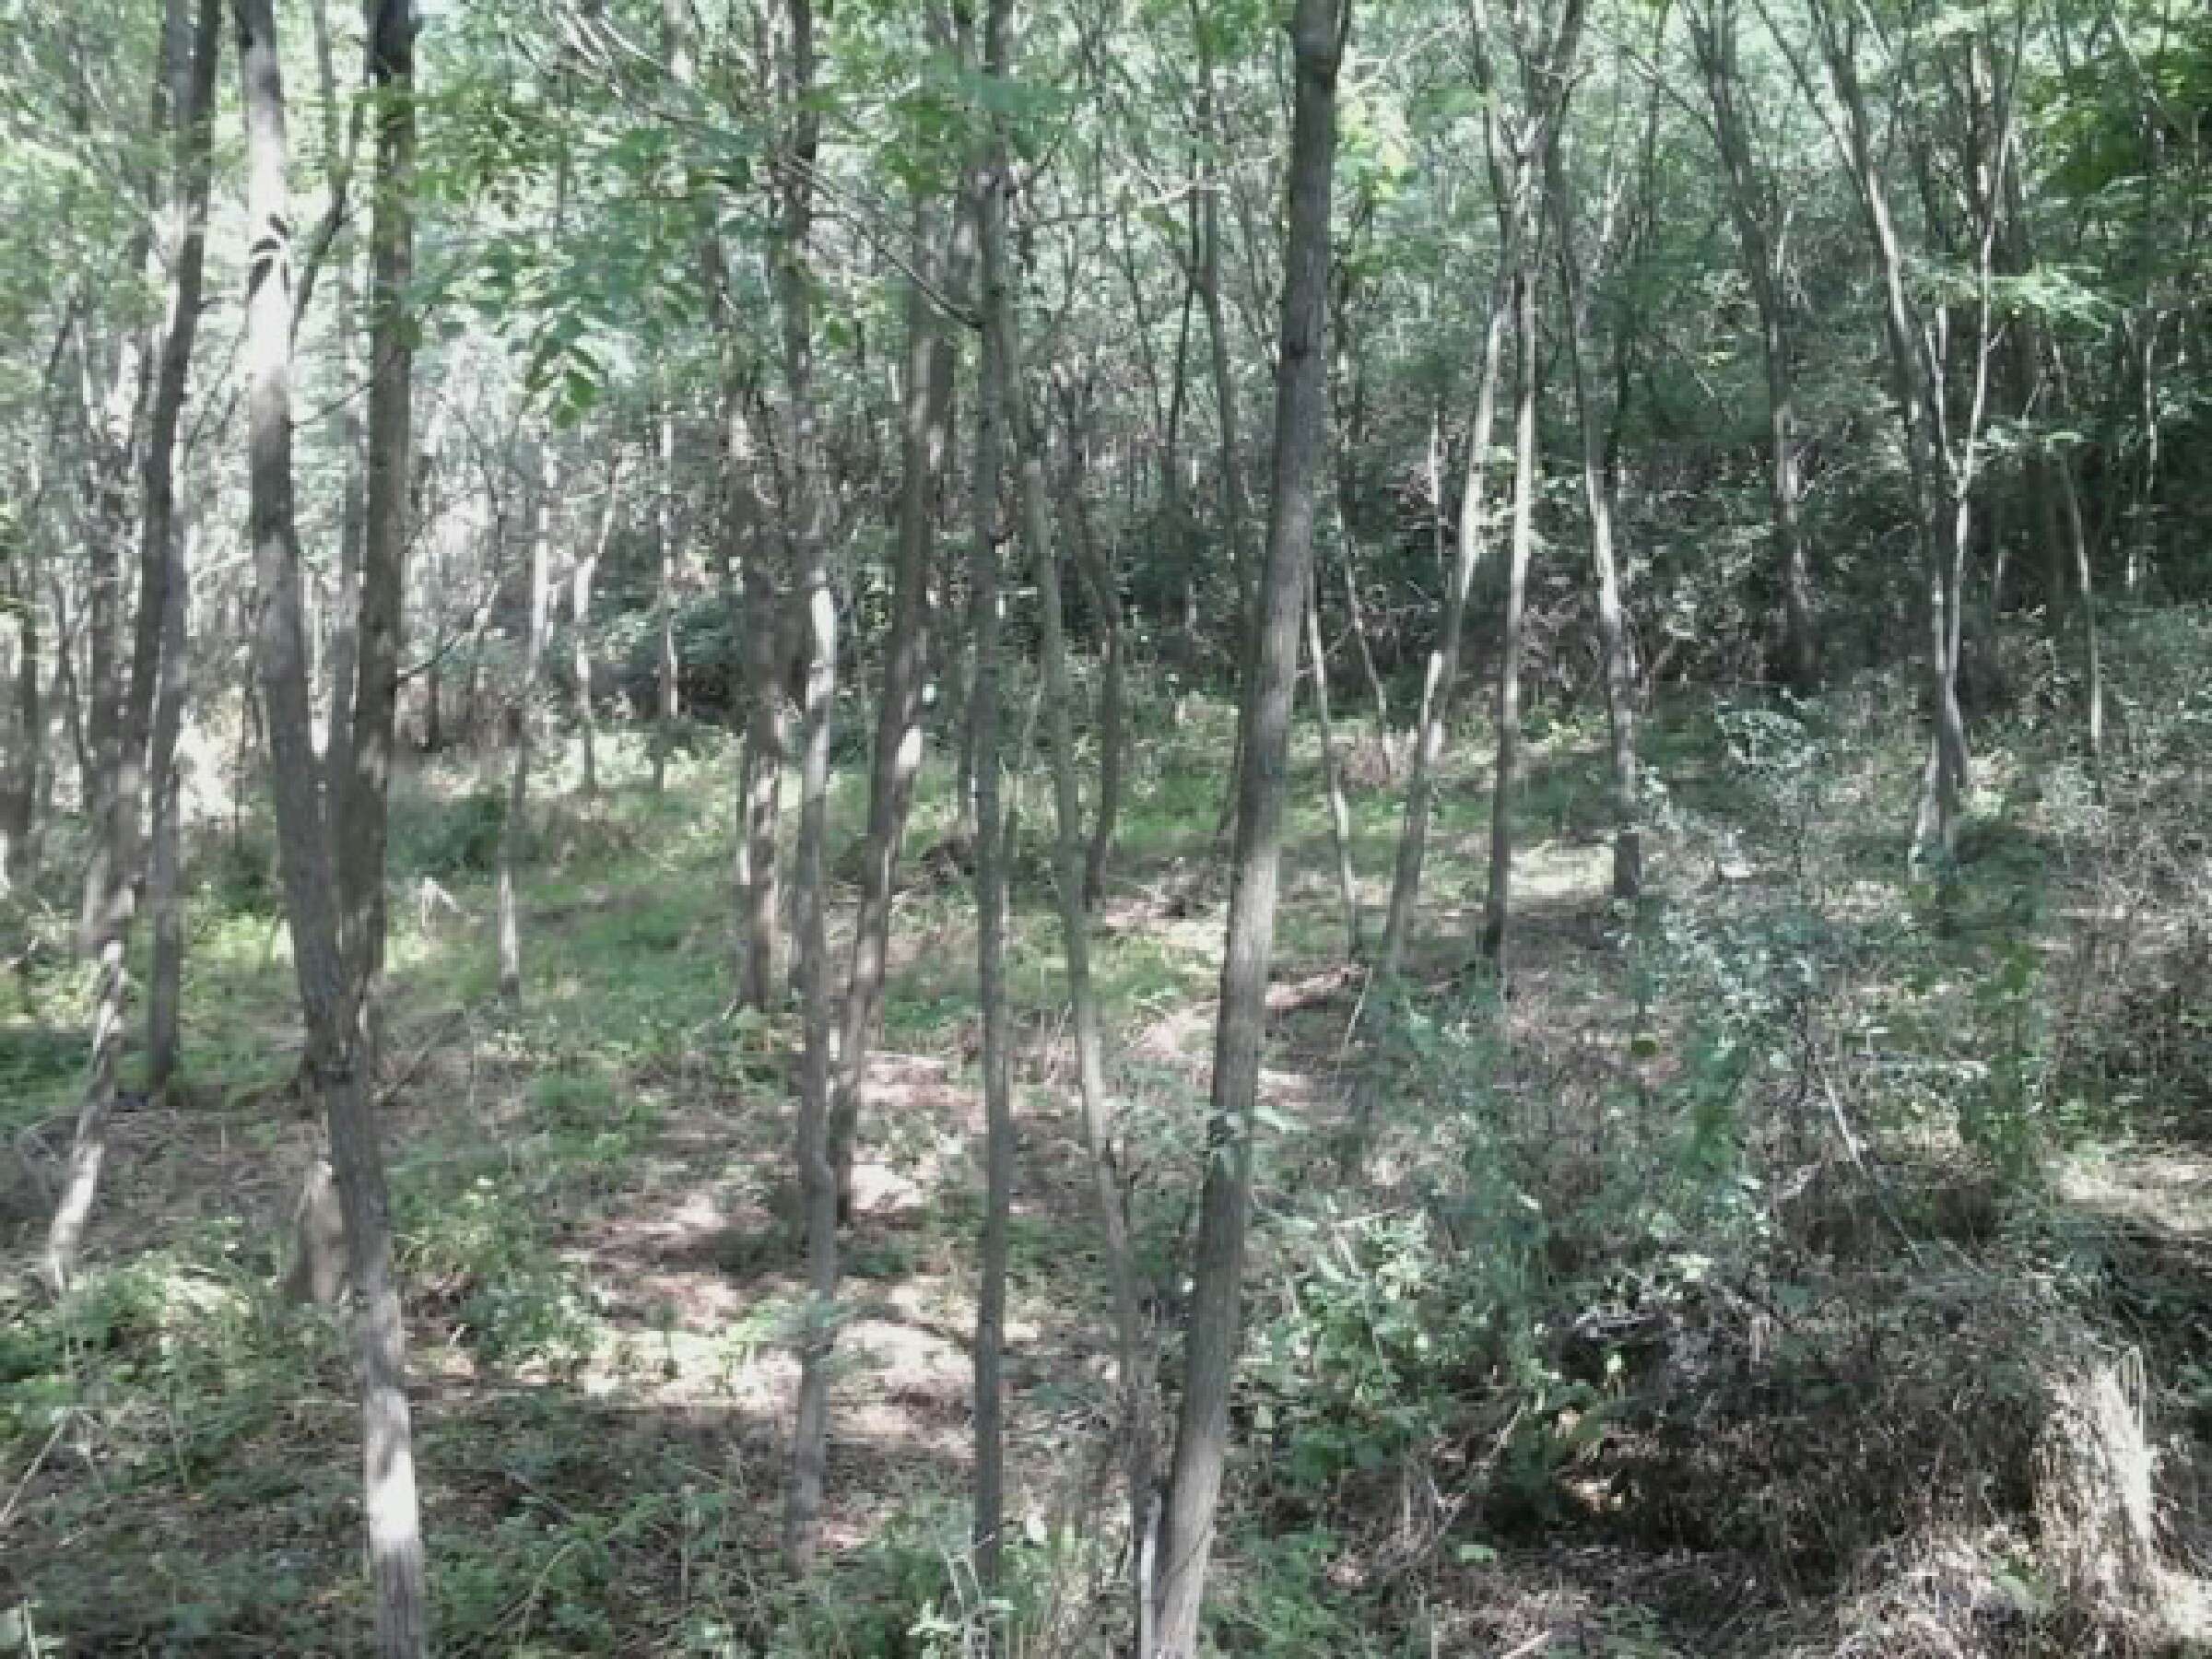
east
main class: Woodland
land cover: Broadleaved woodland
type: exotic forest
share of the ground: > 75 %
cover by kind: broadleaved forest trees 100 %
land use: Forestry
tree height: > 5 m
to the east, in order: Broadleaved woodland; Shrubland without tree cover; Spontaneously vegetated surfaces; Tracks; Common wheat
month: August
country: HU
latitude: 47.9317
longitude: 19.3781
